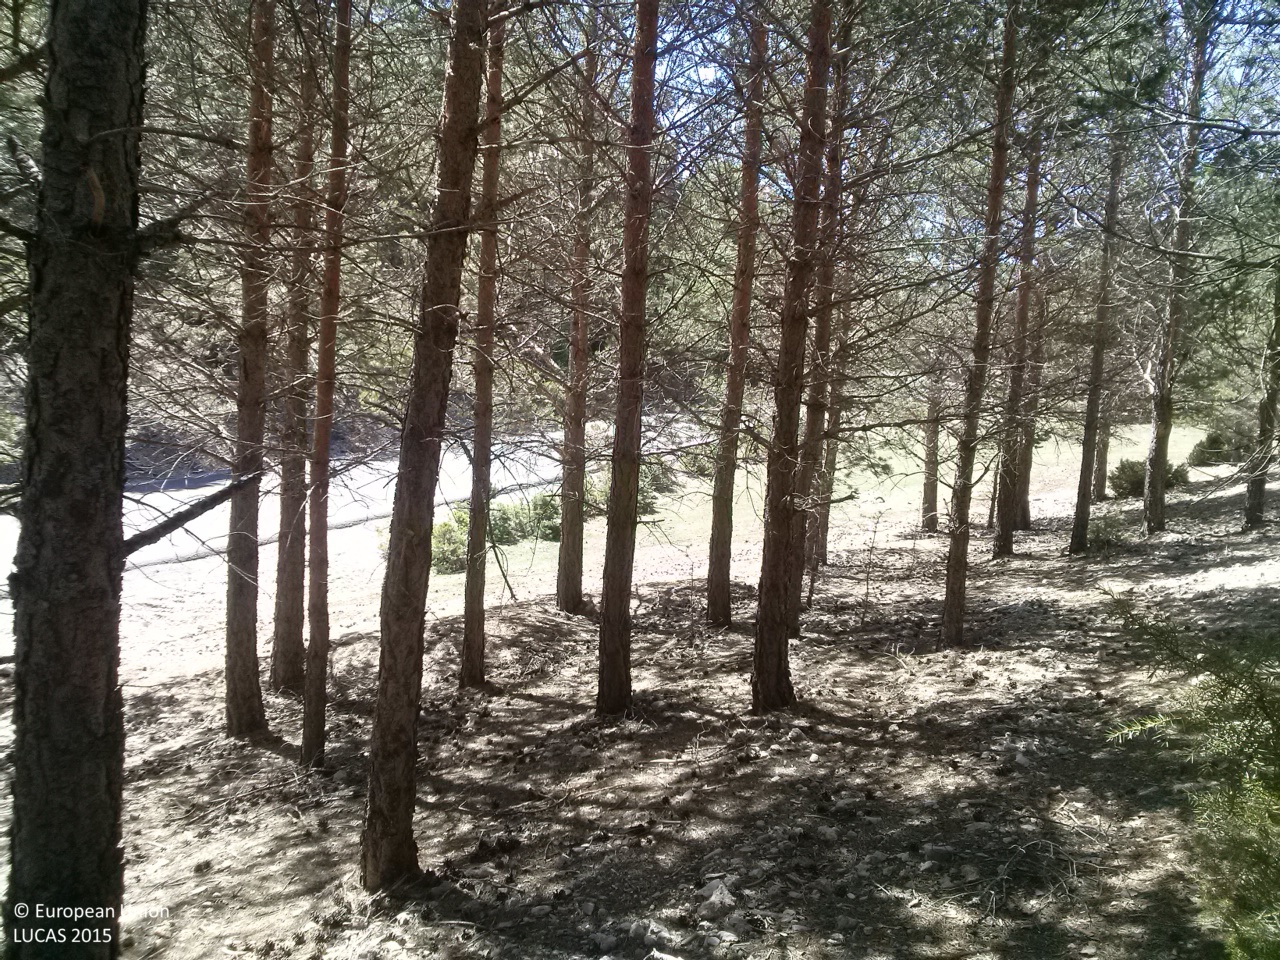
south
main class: Woodland
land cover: Pine dominated coniferous woodland
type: coniferous forest of the mediterranean region
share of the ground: > 75 %
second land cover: Grassland without tree/shrub cover
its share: 50 - 75 %
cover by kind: coniferous forest trees 75 %, herbaceous plants 15 %, shrubs 5 %, unconsolidated bare surface 5 %
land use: Forestry
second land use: Agriculture (excluding fallow land and kitchen gardens)
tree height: > 5 m
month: April
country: ES
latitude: 40.3436
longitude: -1.7527
